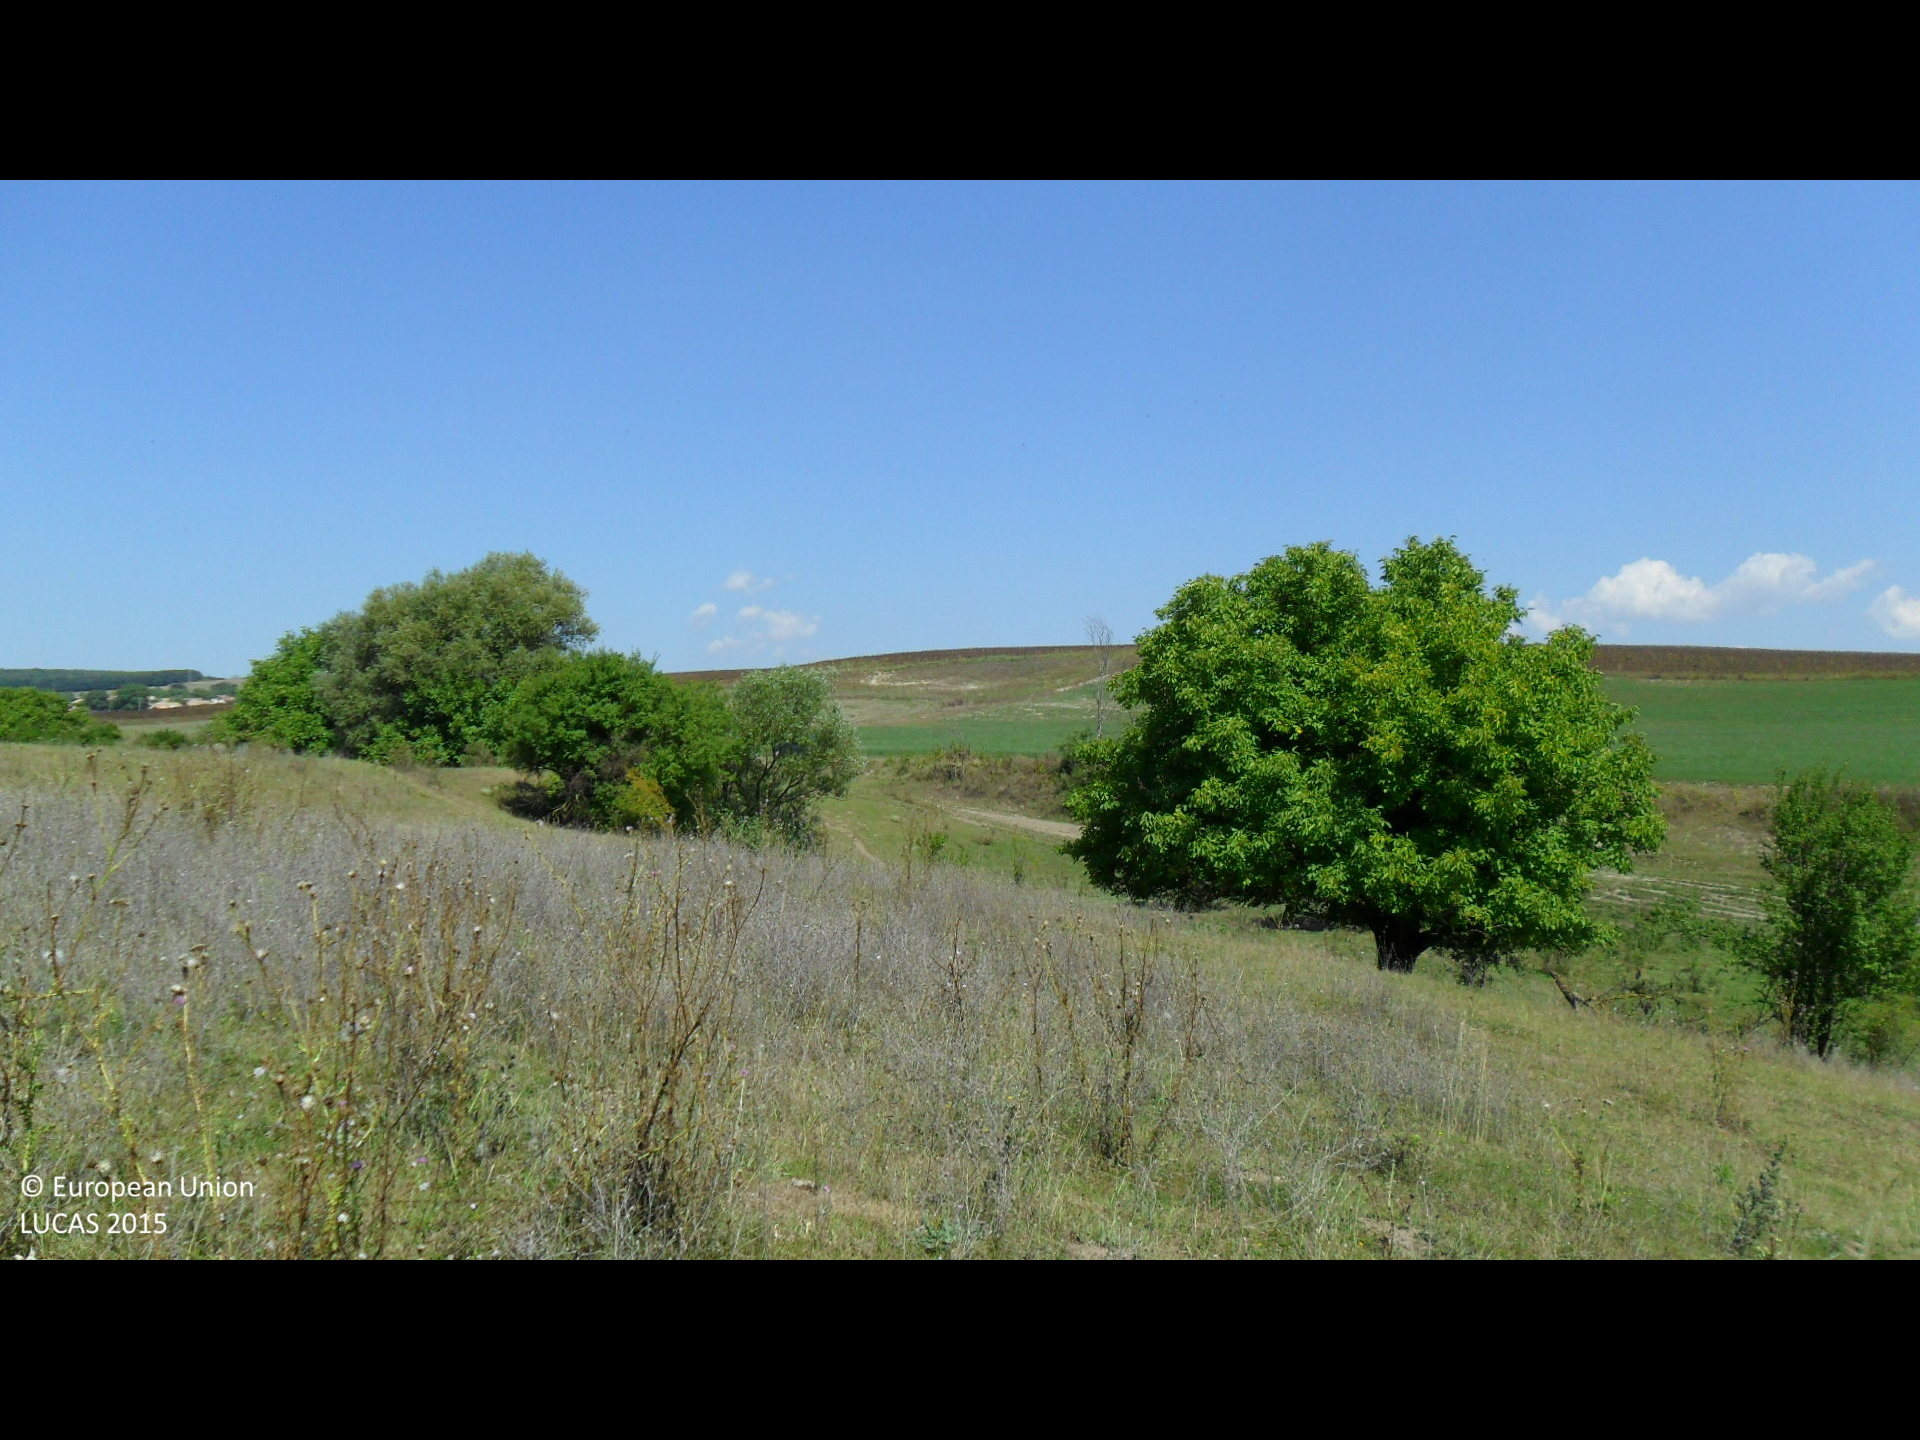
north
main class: Grassland
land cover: Grassland without tree/shrub cover
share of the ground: > 75 %
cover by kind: herbaceous plants 100 %
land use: Agriculture (excluding fallow land and kitchen gardens)
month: August
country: BG
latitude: 43.4377
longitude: 26.2961
